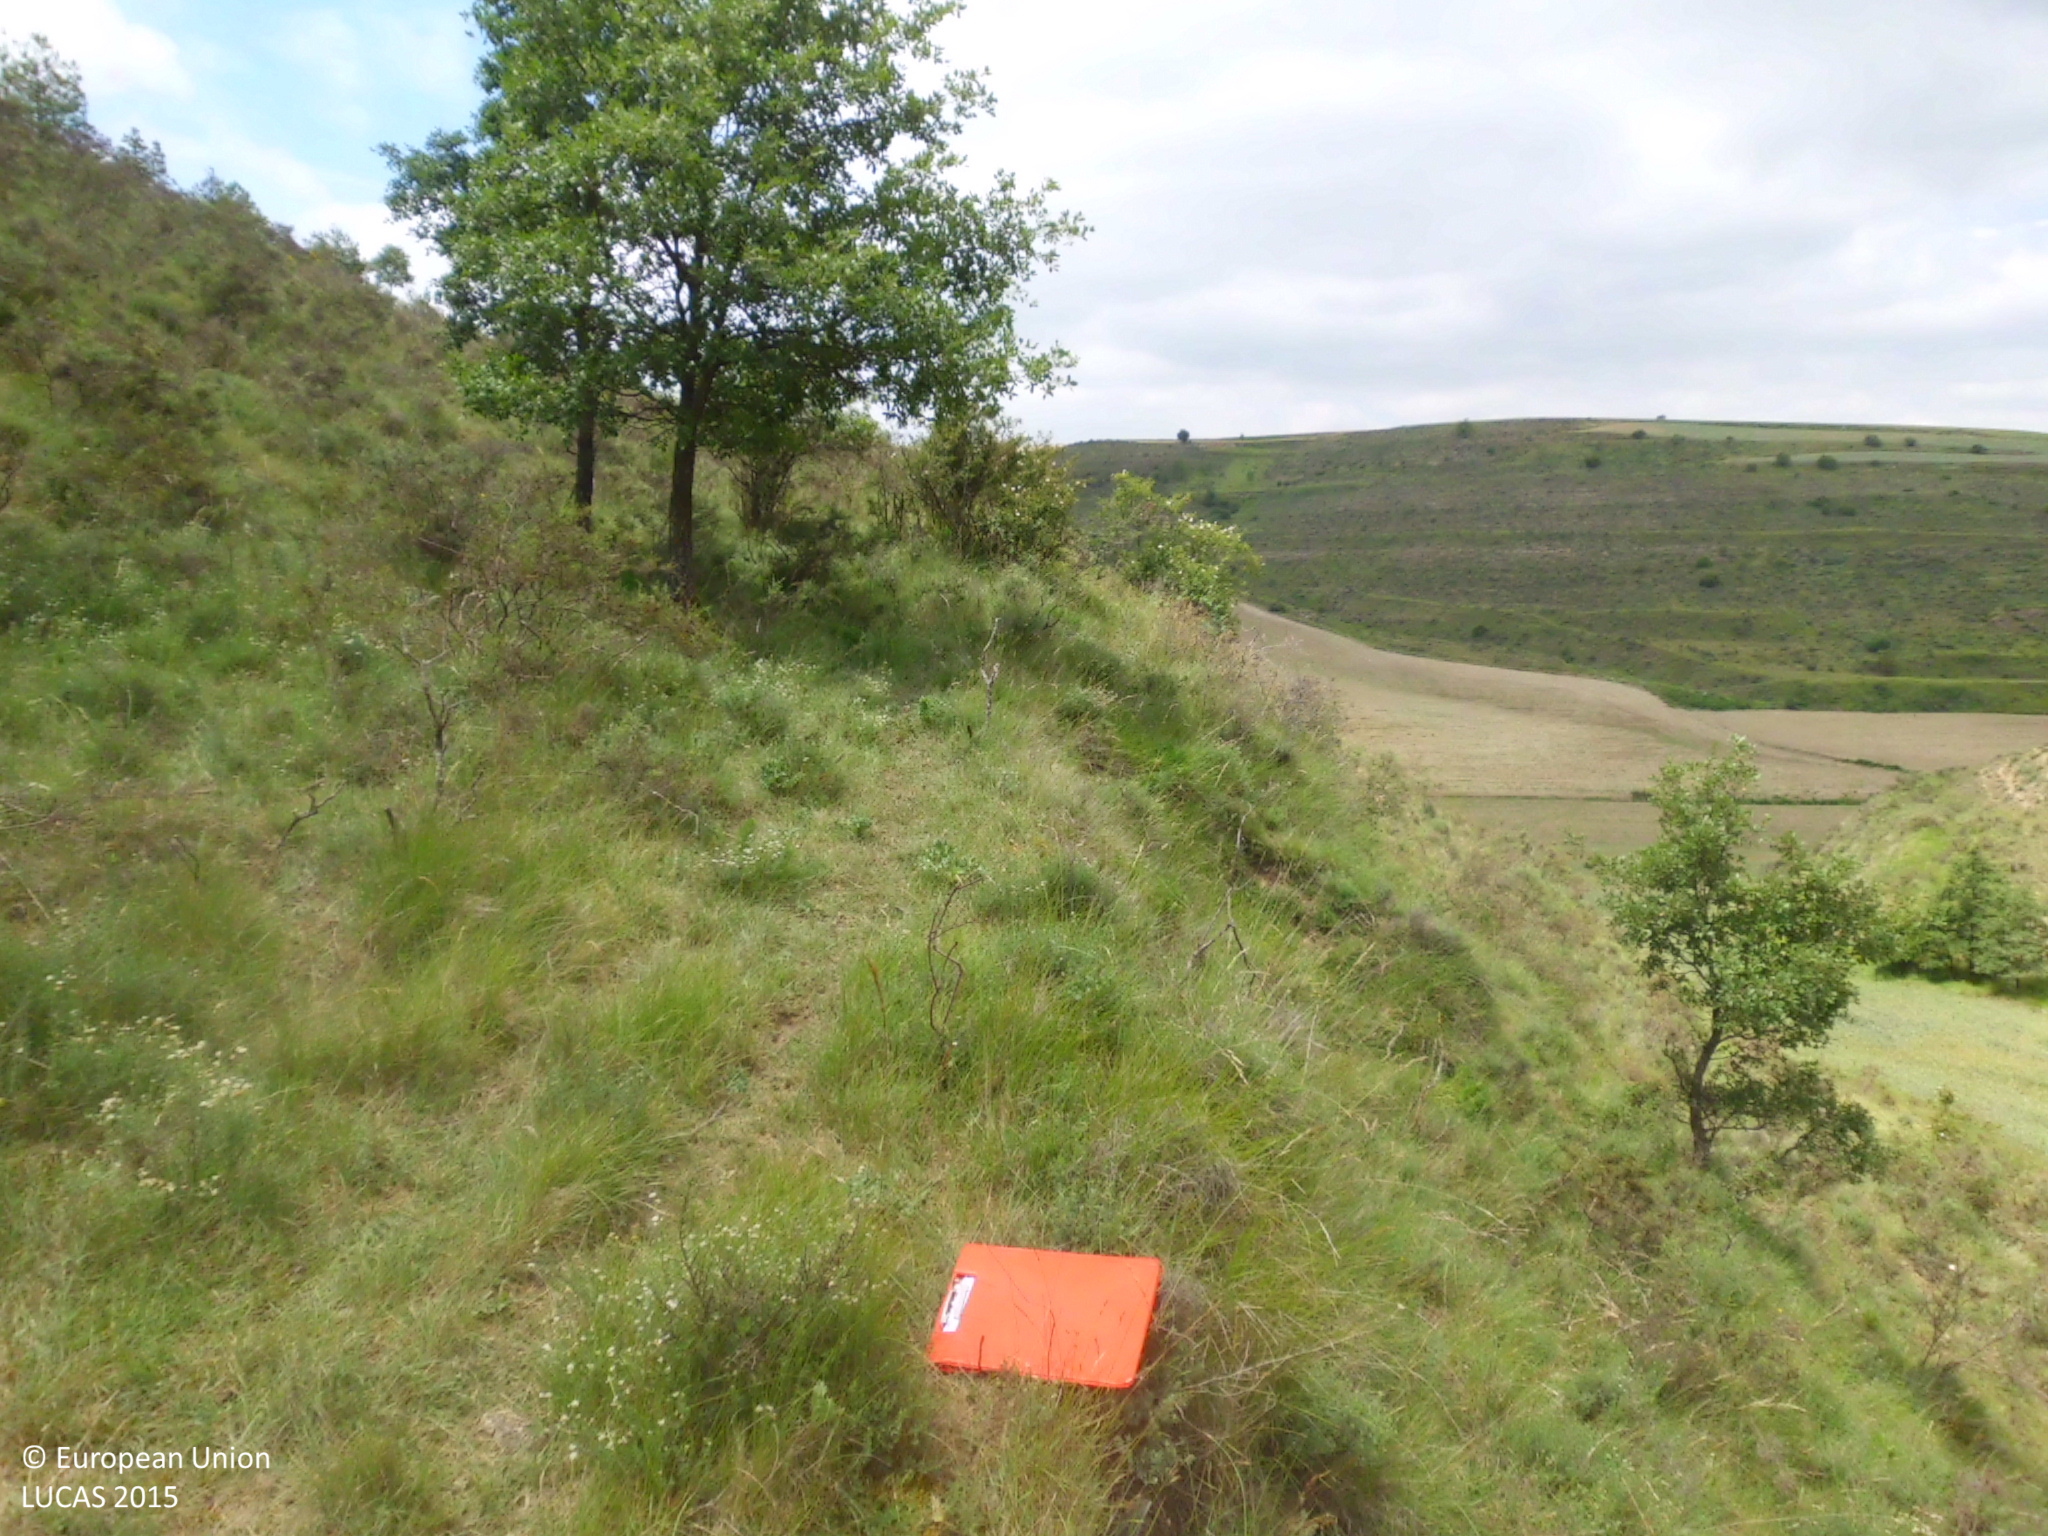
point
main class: Shrubland
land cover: Shrubland without tree cover
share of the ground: 50 - 75 %
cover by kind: shrubs 55 %, herbaceous plants 30 %, consolidated bare surface 15 %
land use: Semi-natural and natural areas not in use
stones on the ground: < 10 %
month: June
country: ES
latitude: 42.4752
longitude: -3.3764
